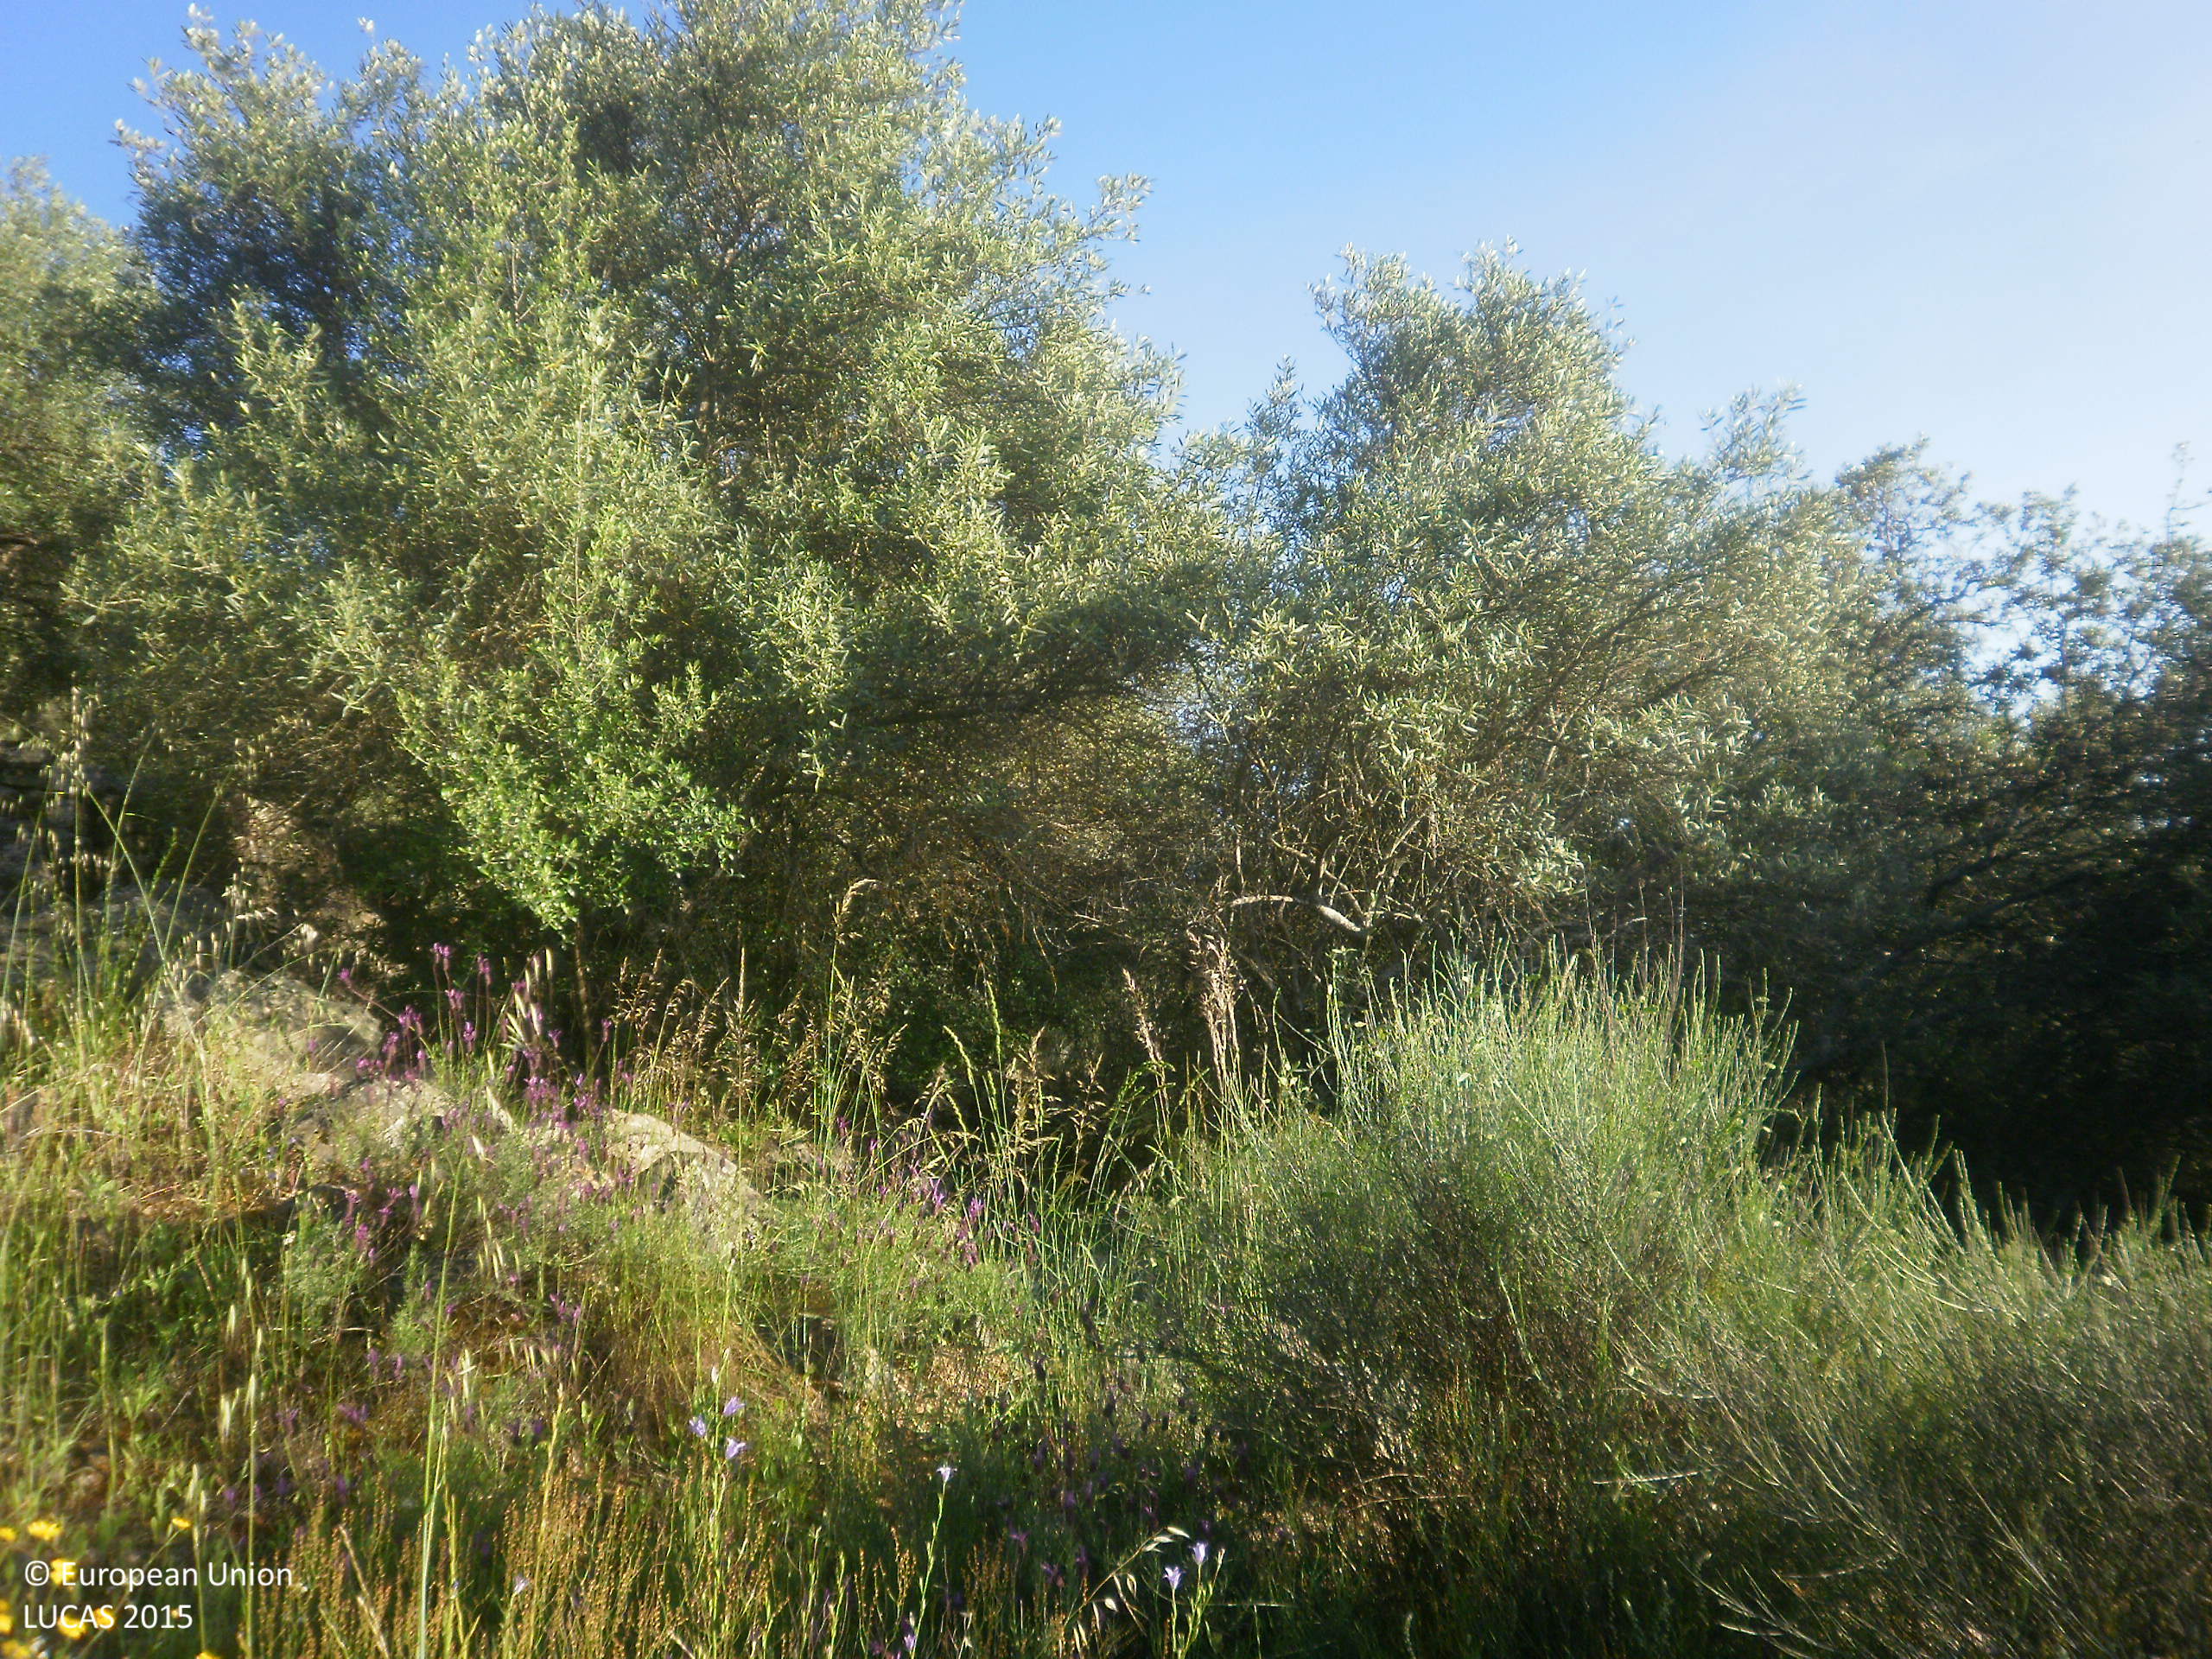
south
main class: Grassland
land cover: Grassland with sparse tree/shrub cover
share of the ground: > 75 %
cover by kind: herbaceous plants 90 %, broadleaved forest trees 5 %, shrubs 5 %
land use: Agriculture (excluding fallow land and kitchen gardens)
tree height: > 5 m
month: April
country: ES
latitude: 38.9591
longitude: -5.2370
